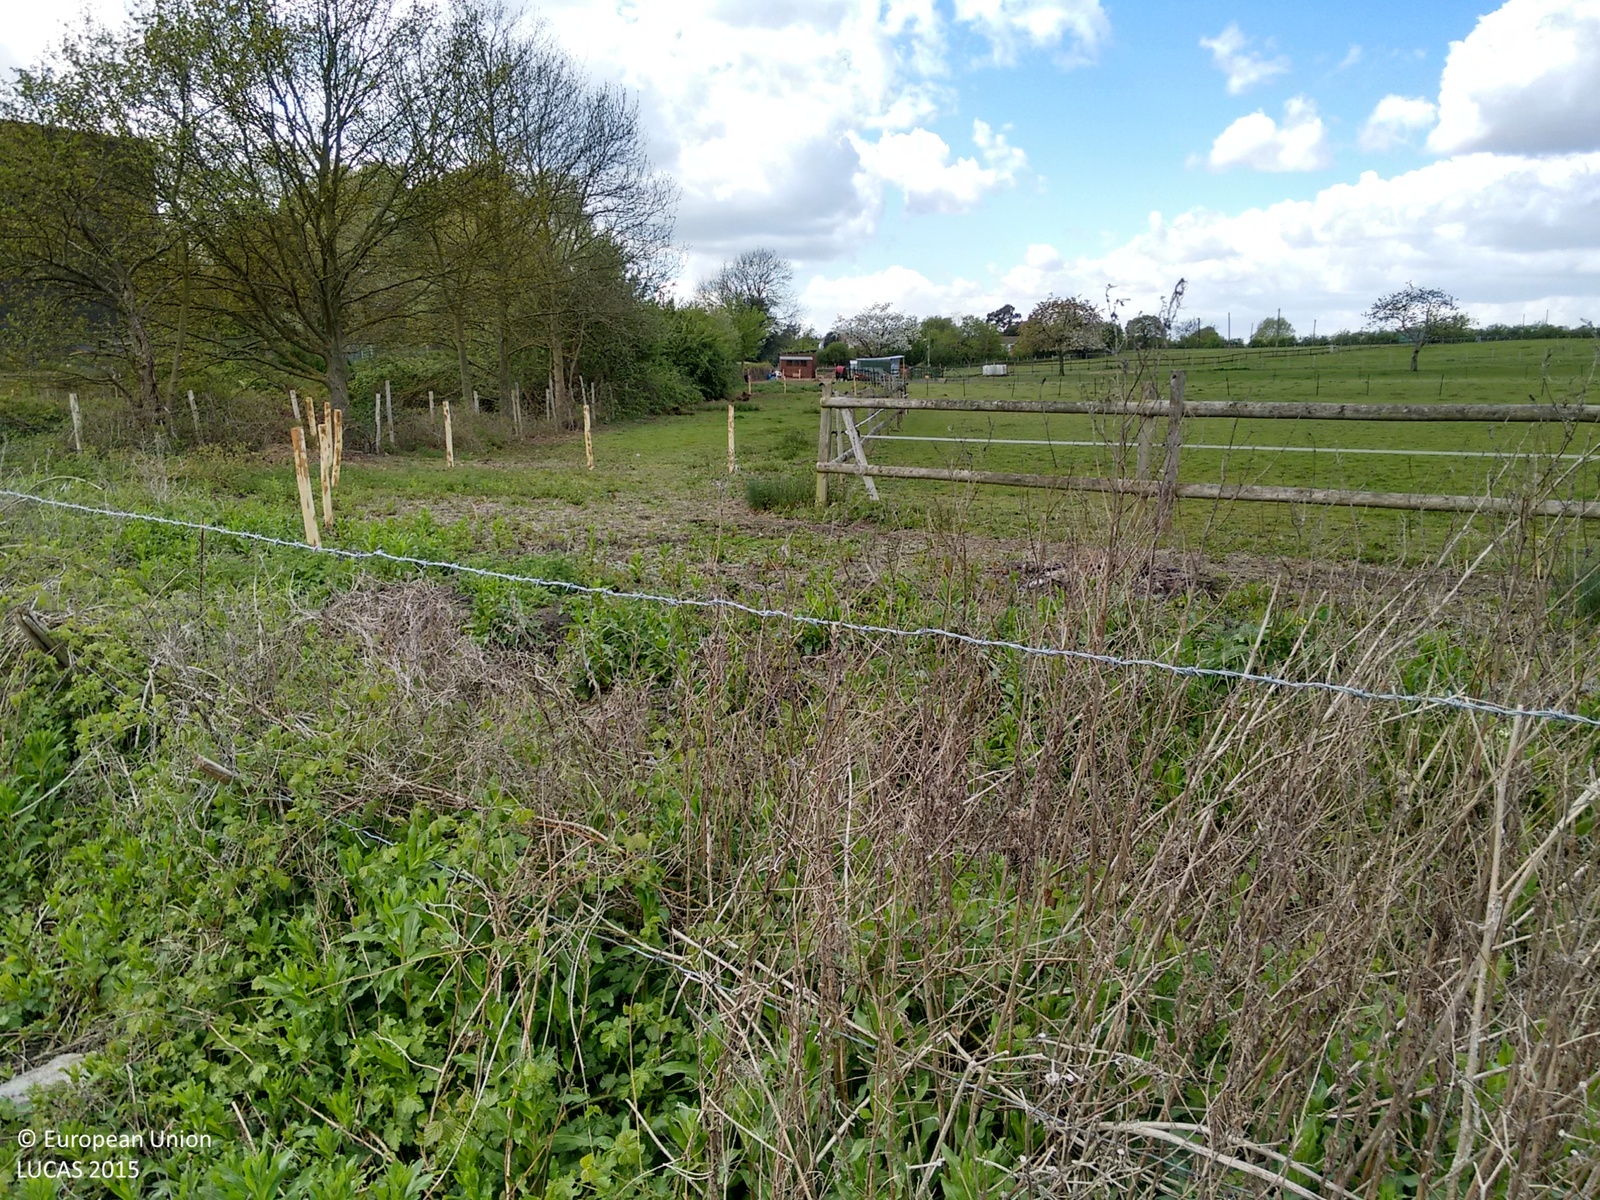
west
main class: Grassland
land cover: Grassland without tree/shrub cover
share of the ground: > 75 %
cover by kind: herbaceous plants 100 %
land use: Agriculture (excluding fallow land and kitchen gardens)
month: April
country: GB
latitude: 51.3069
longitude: 0.4901
